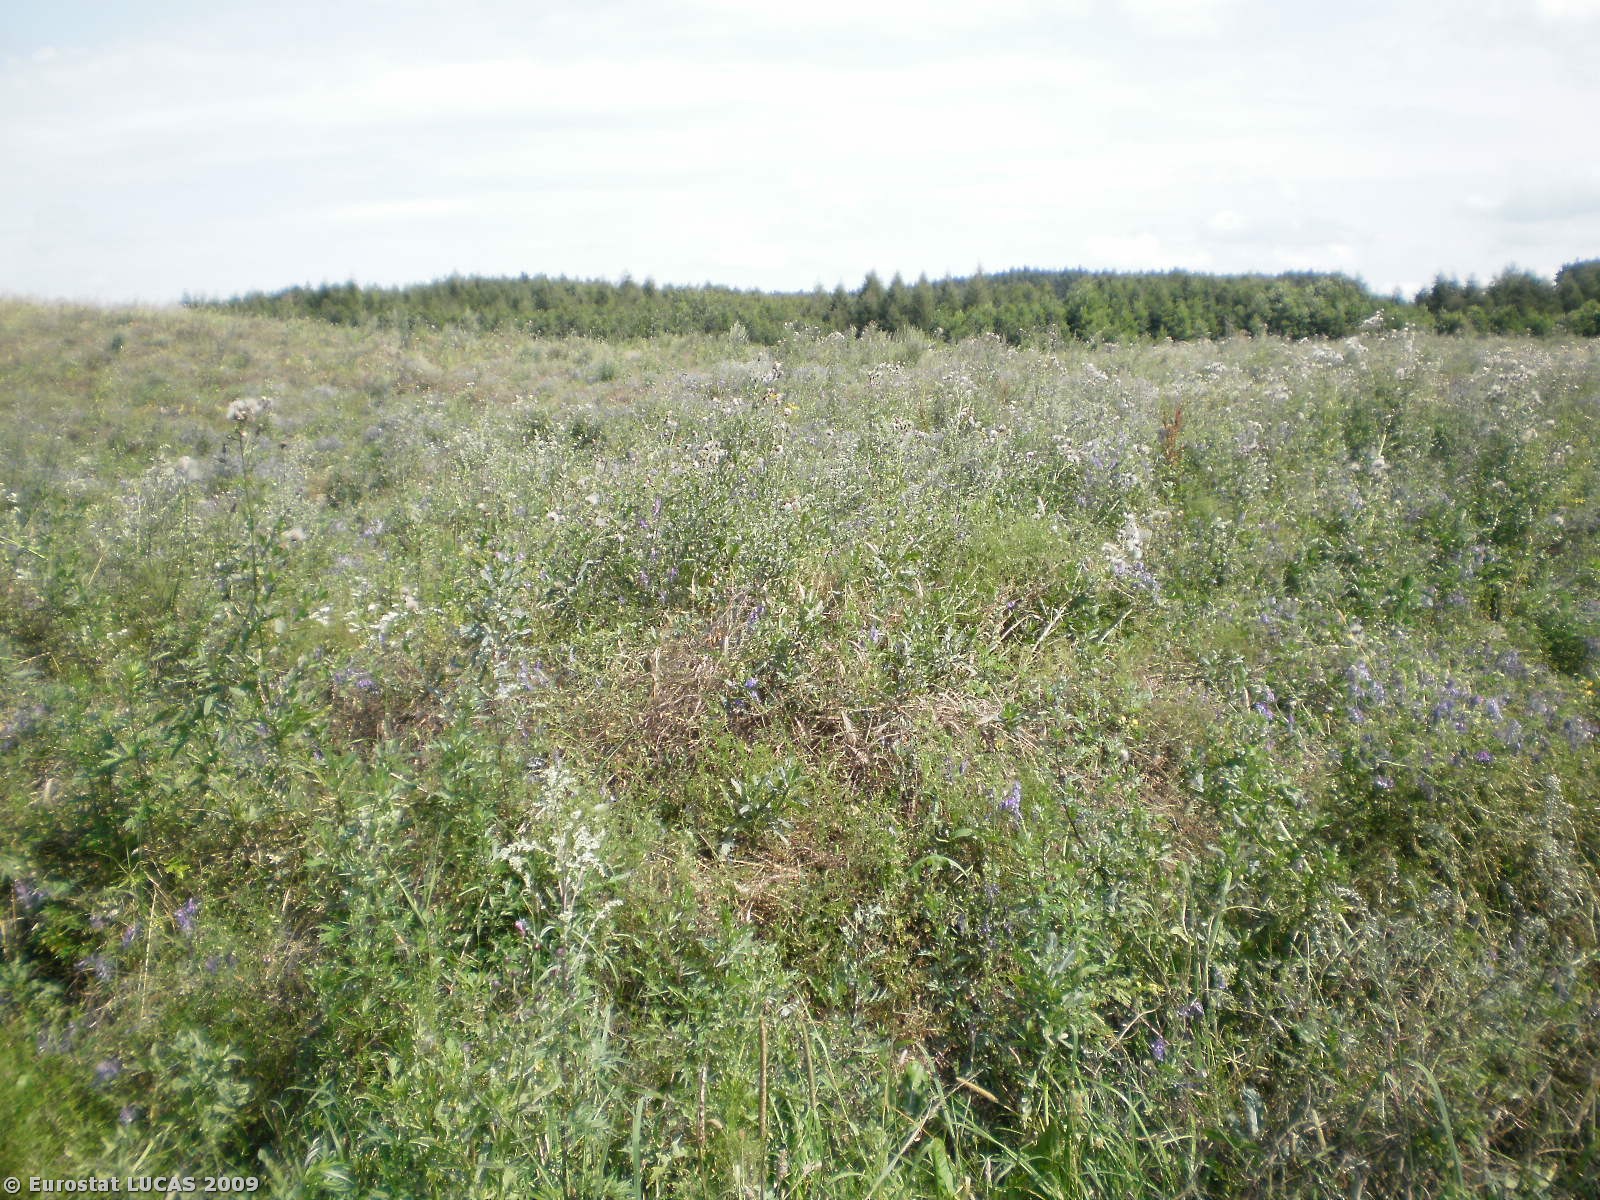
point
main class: Shrubland
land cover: Shrubland with sparse tree cover
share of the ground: > 75 %
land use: Unused
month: July
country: PL
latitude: 53.8929
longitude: 20.6444
